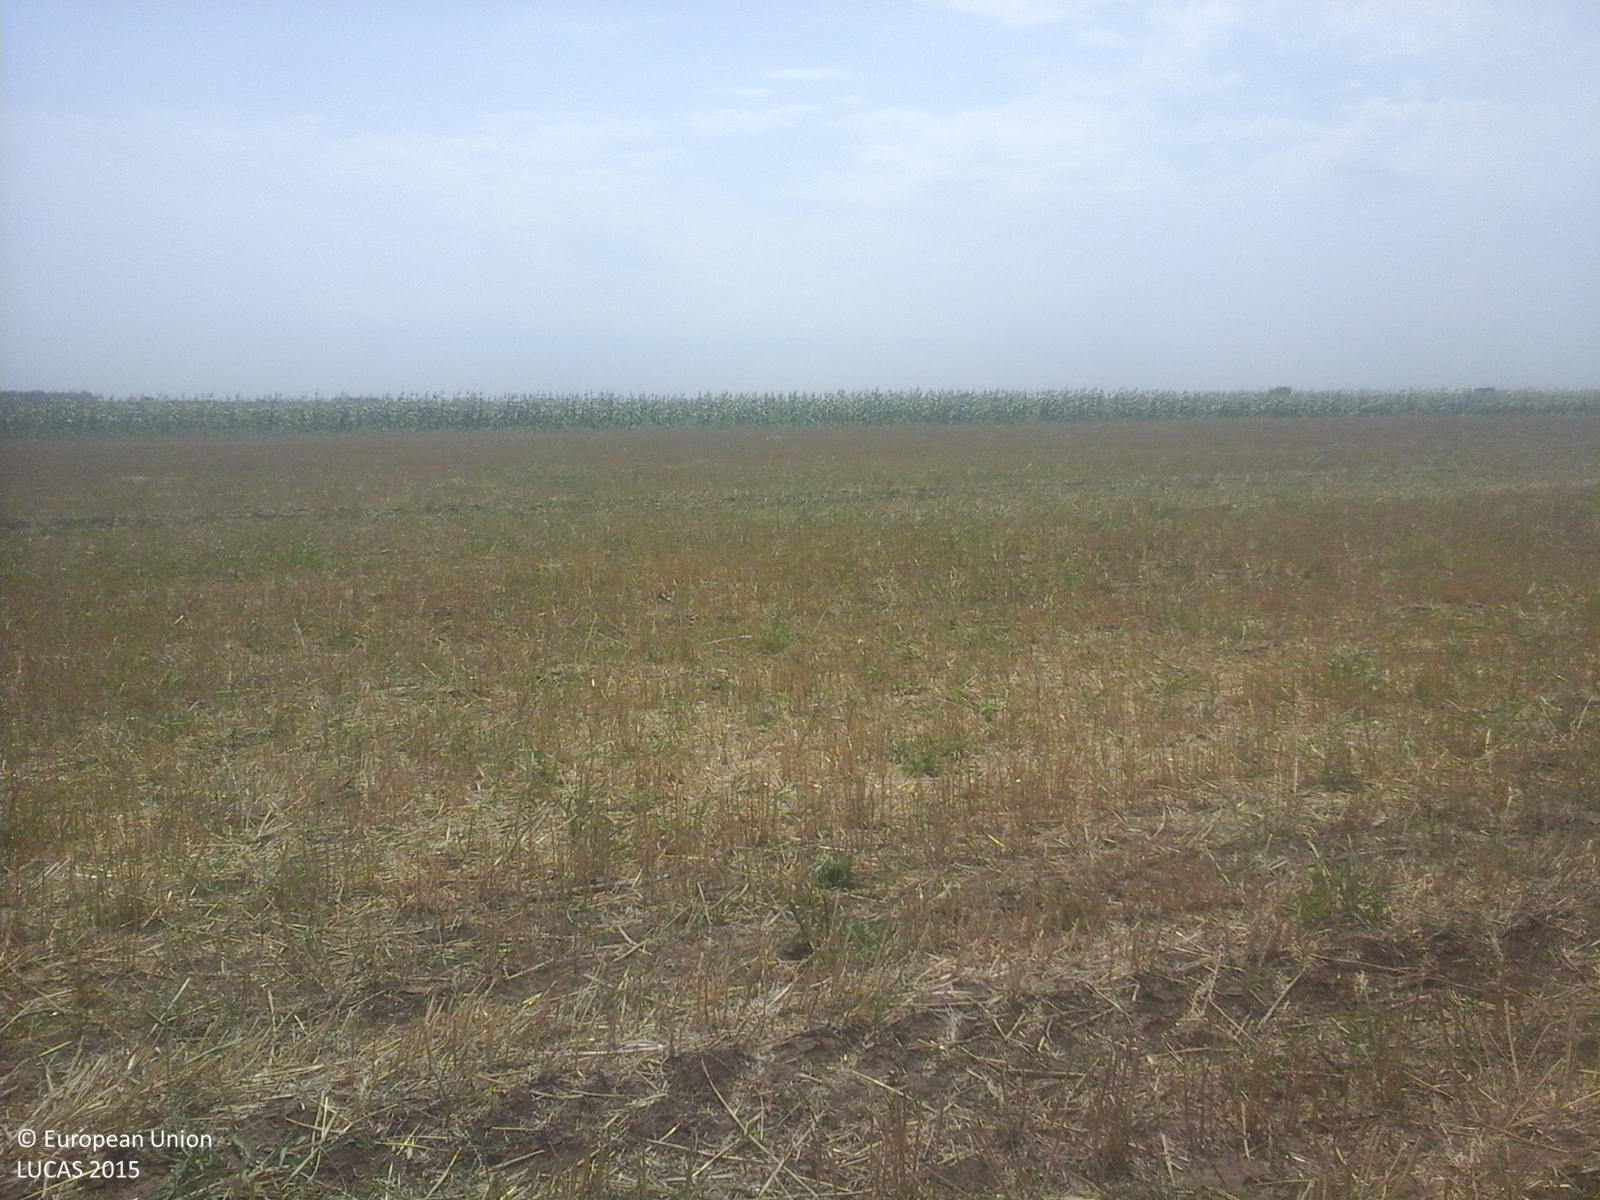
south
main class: Cropland
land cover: Barley
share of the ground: 50 - 75 %
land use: Agriculture (excluding fallow land and kitchen gardens)
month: August
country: RO
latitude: 44.1583
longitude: 28.3328
